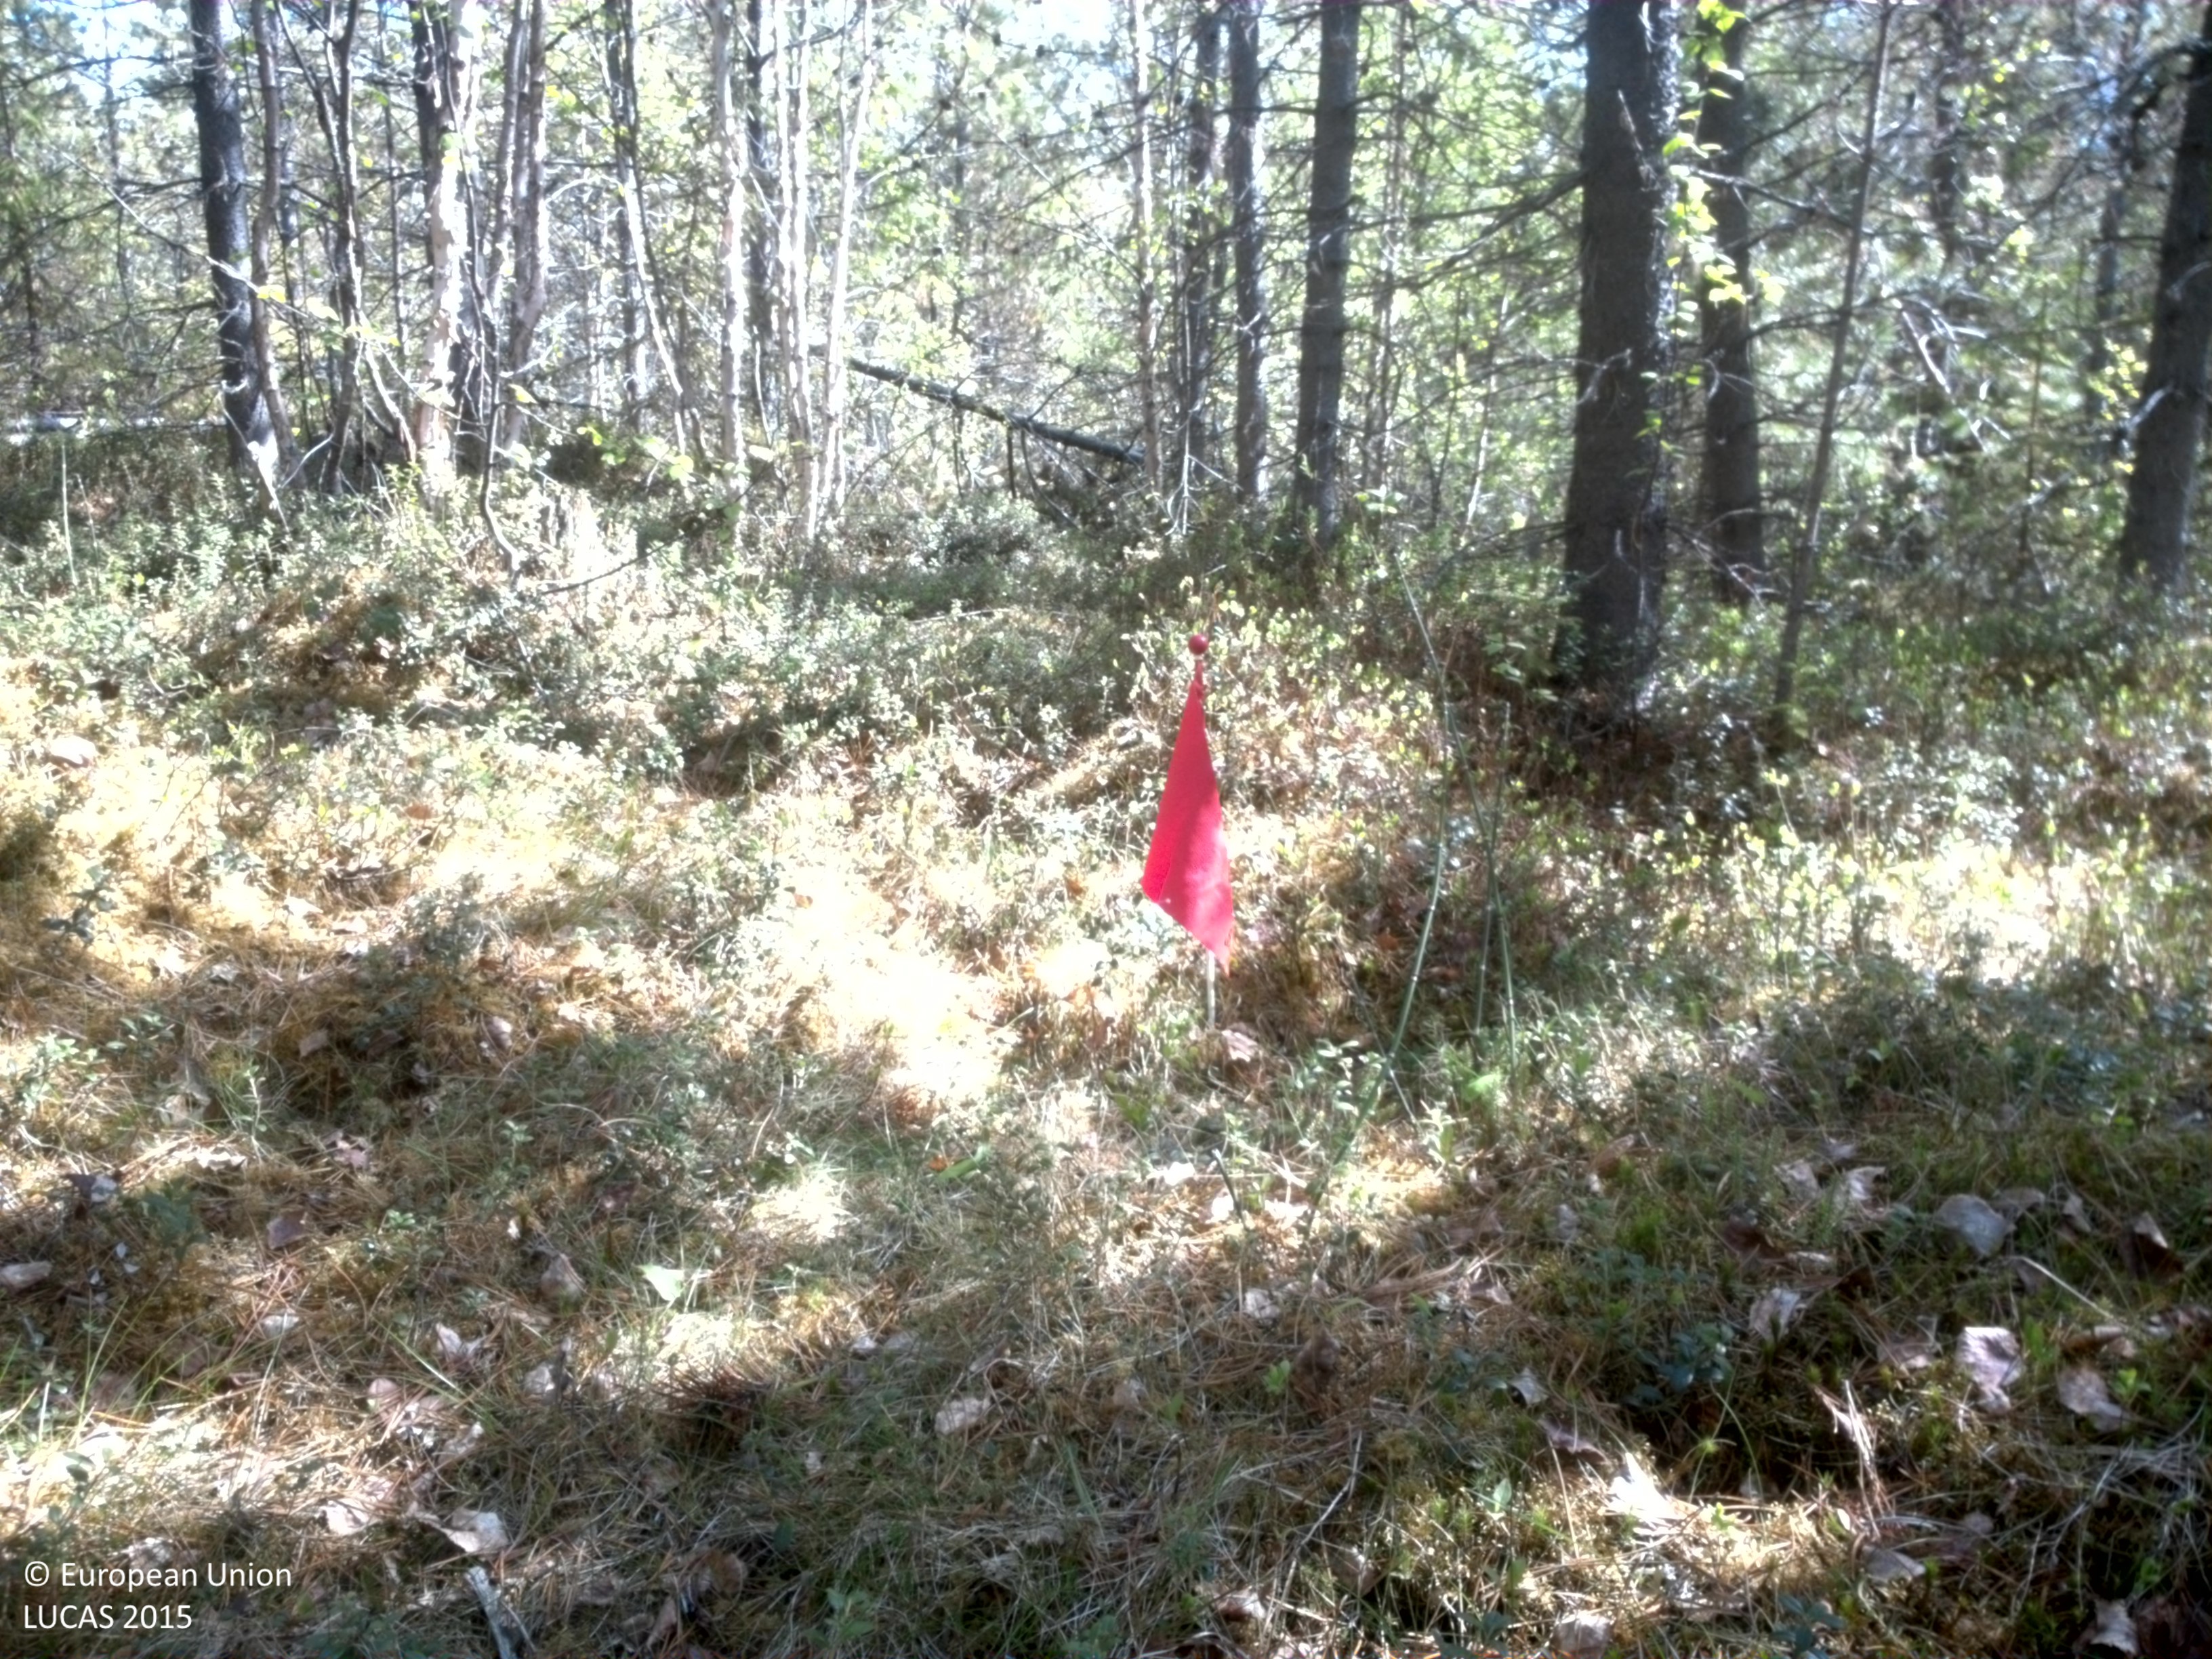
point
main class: Woodland
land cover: Pine dominated mixed woodland
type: boreal forest
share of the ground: 50 - 75 %
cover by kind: coniferous forest trees 40 %, shrubs 35 %, broadleaved forest trees 15 %, lichens and mosses 10 %
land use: Forestry
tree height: > 5 m
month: June
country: SE
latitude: 66.8821
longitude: 21.8979
